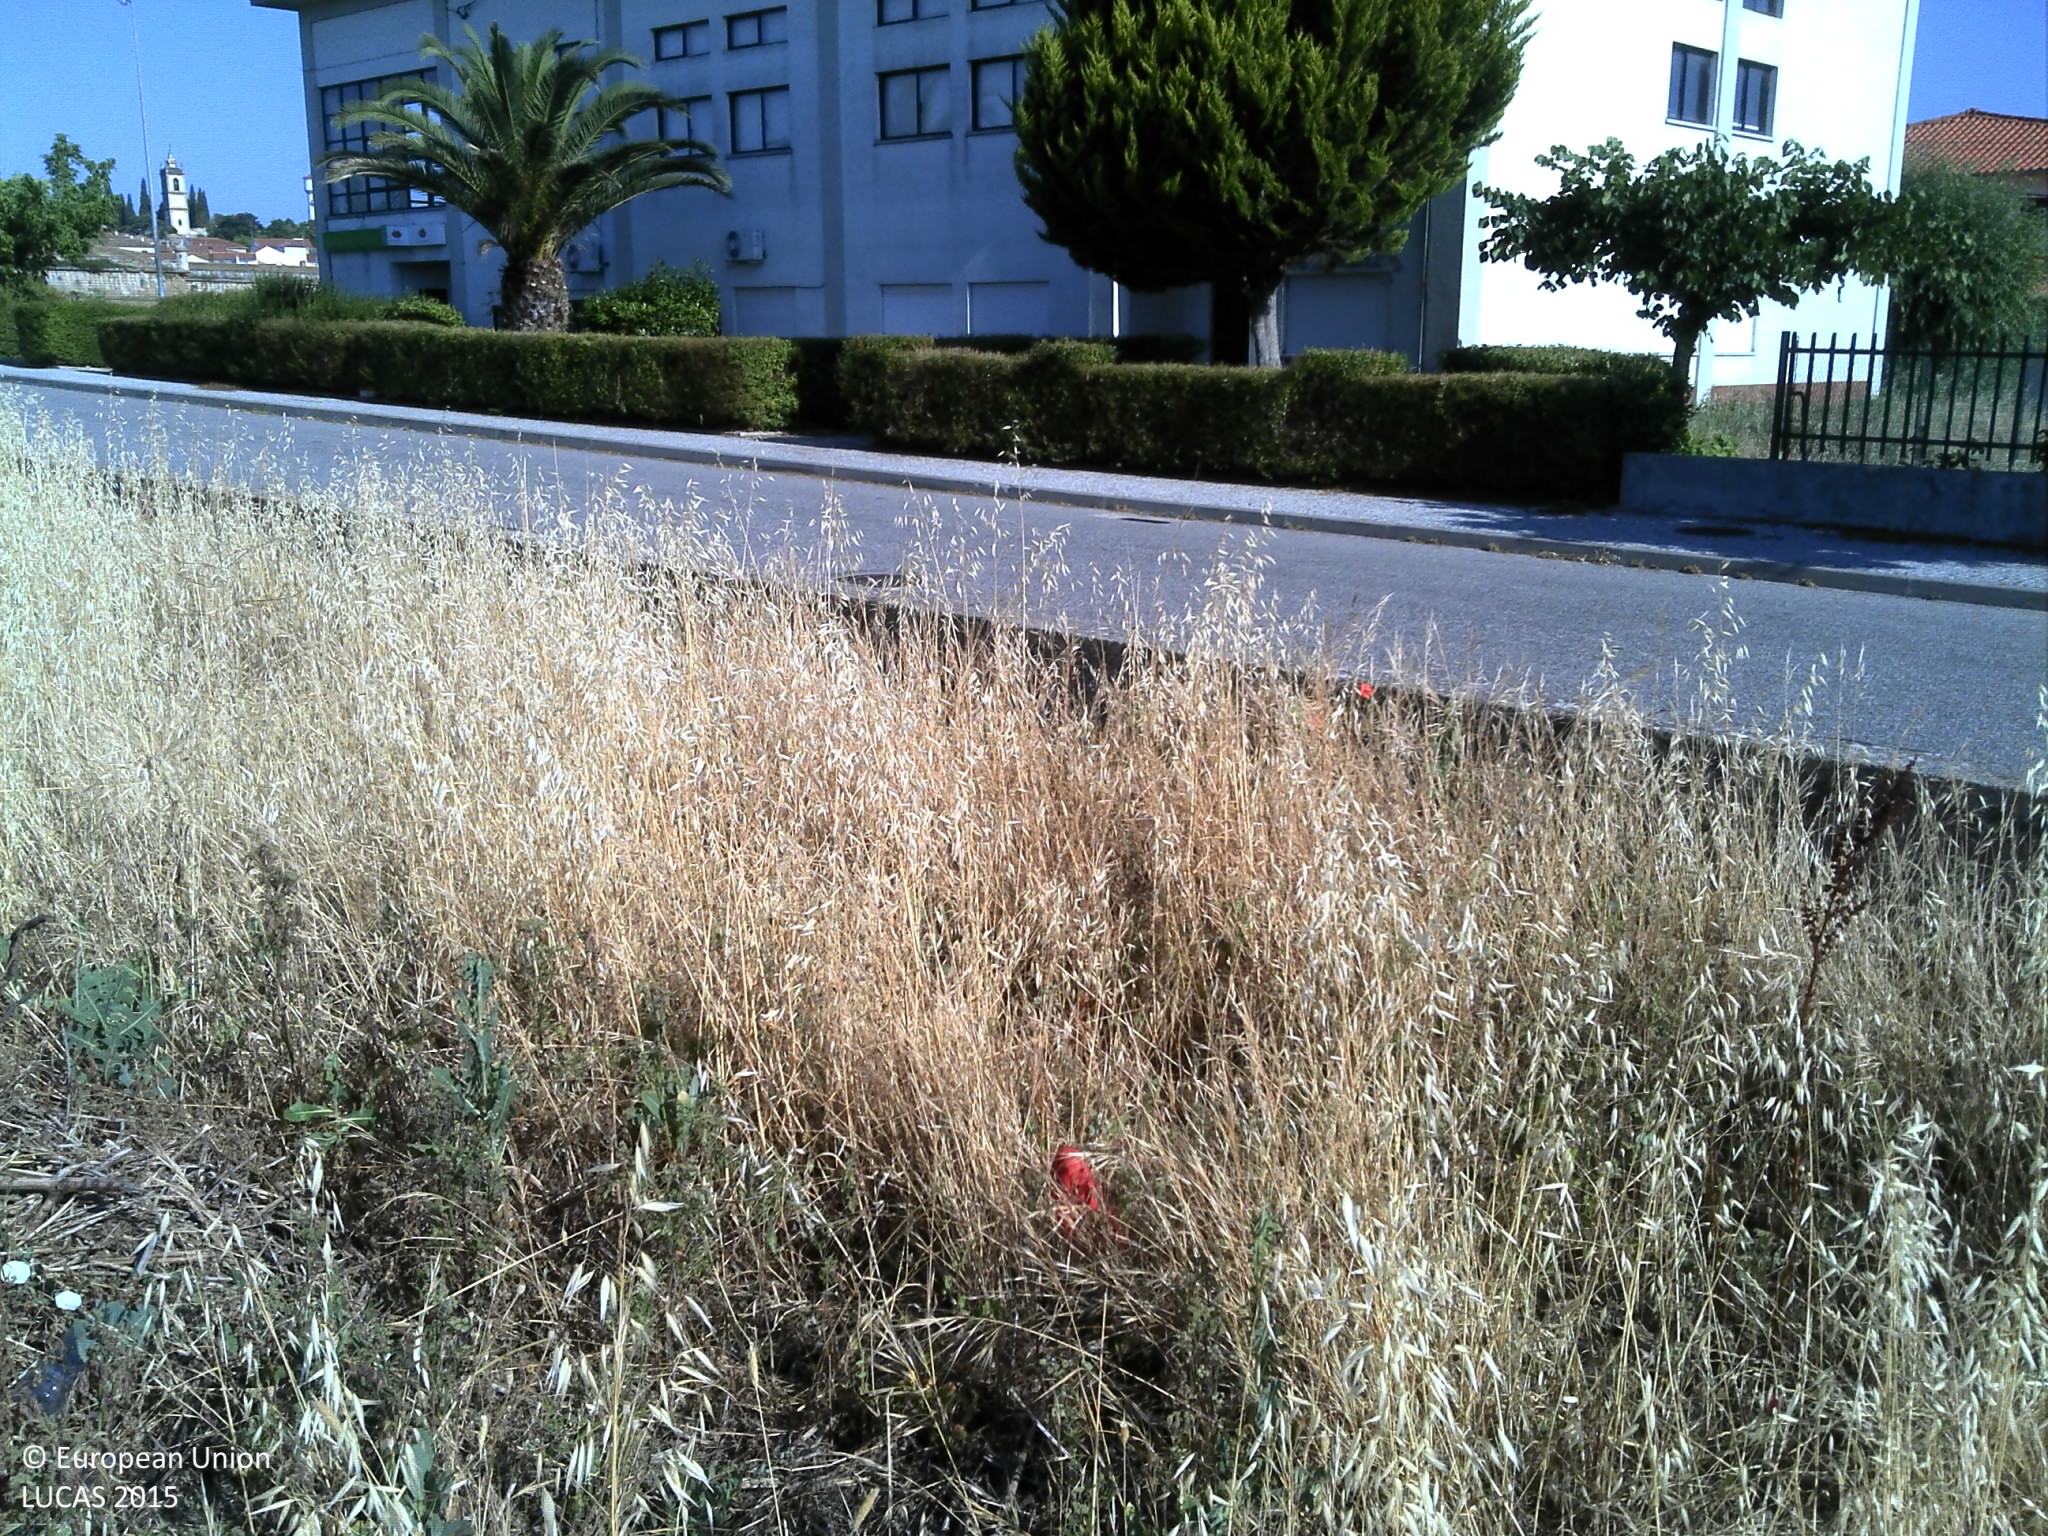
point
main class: Grassland
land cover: Spontaneously vegetated surfaces
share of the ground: > 75 %
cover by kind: herbaceous plants 100 %
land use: Fallow land
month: June
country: PT
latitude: 40.7245
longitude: -6.9001
